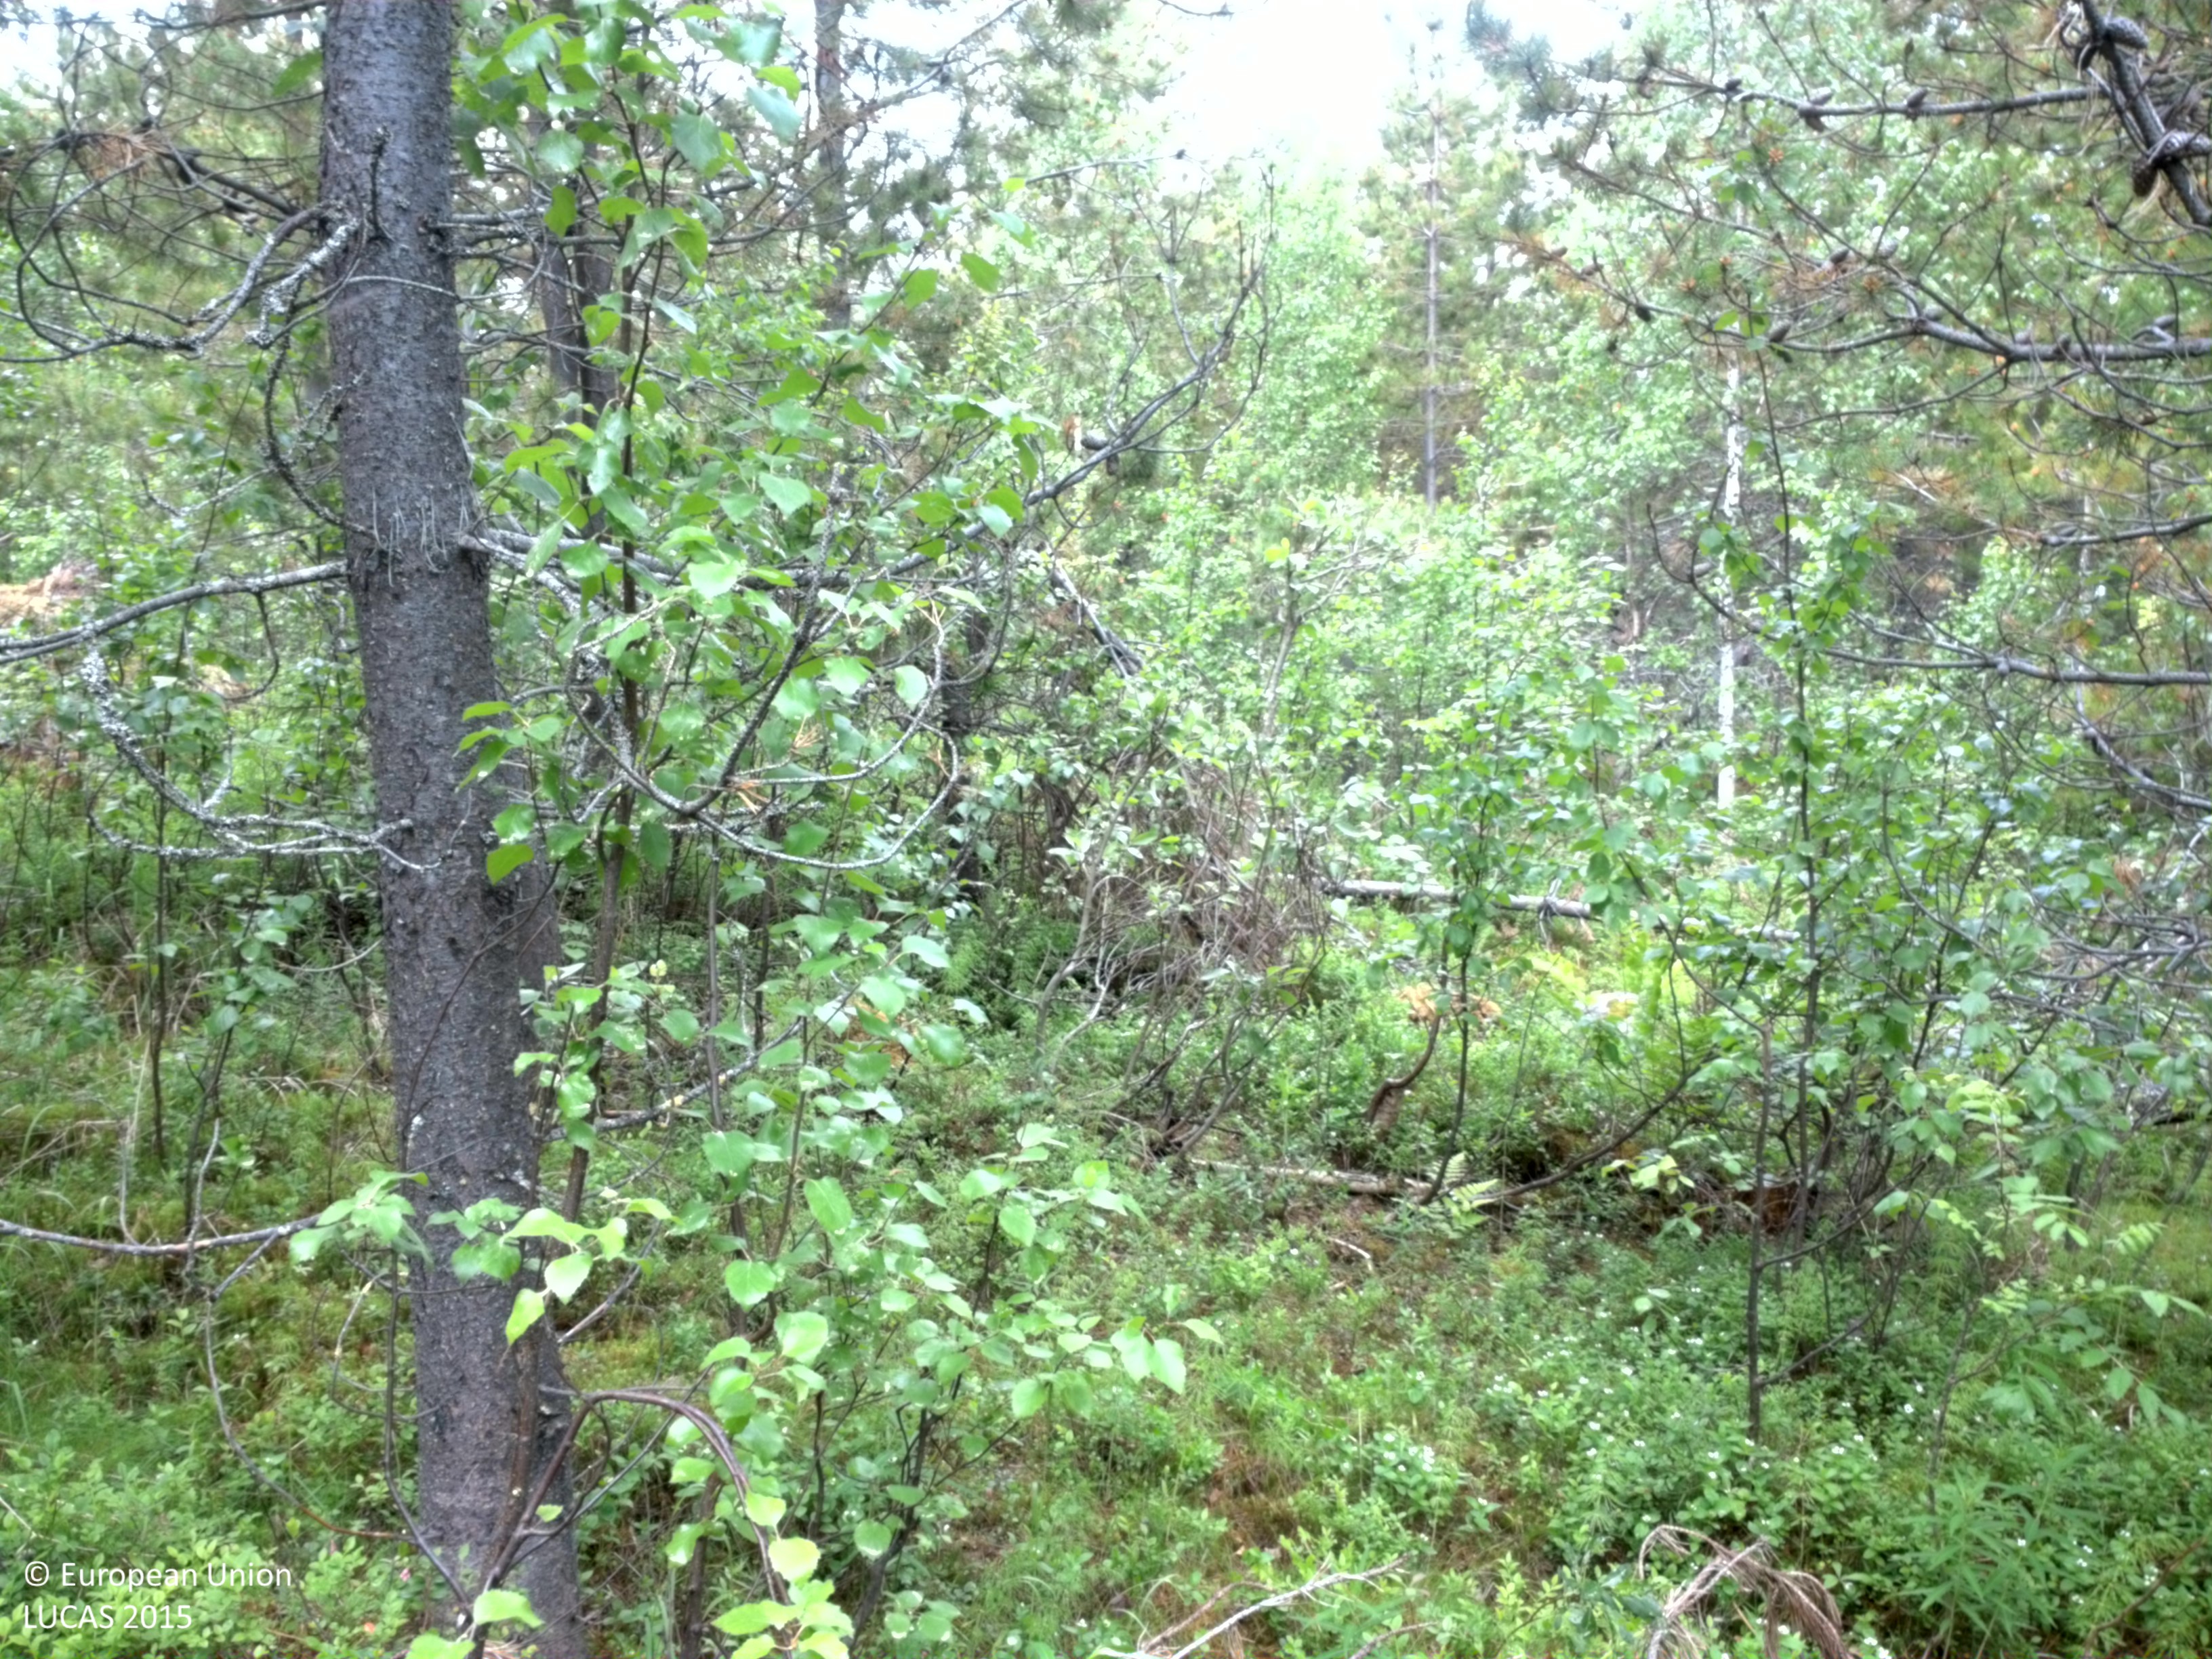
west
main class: Woodland
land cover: Pine dominated coniferous woodland
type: exotic forest
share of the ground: 50 - 75 %
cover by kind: coniferous forest trees 65 %, broadleaved forest trees 15 %, shrubs 15 %, herbaceous plants 5 %
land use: Forestry
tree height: > 5 m
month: July
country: SE
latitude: 64.4700
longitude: 17.9741
